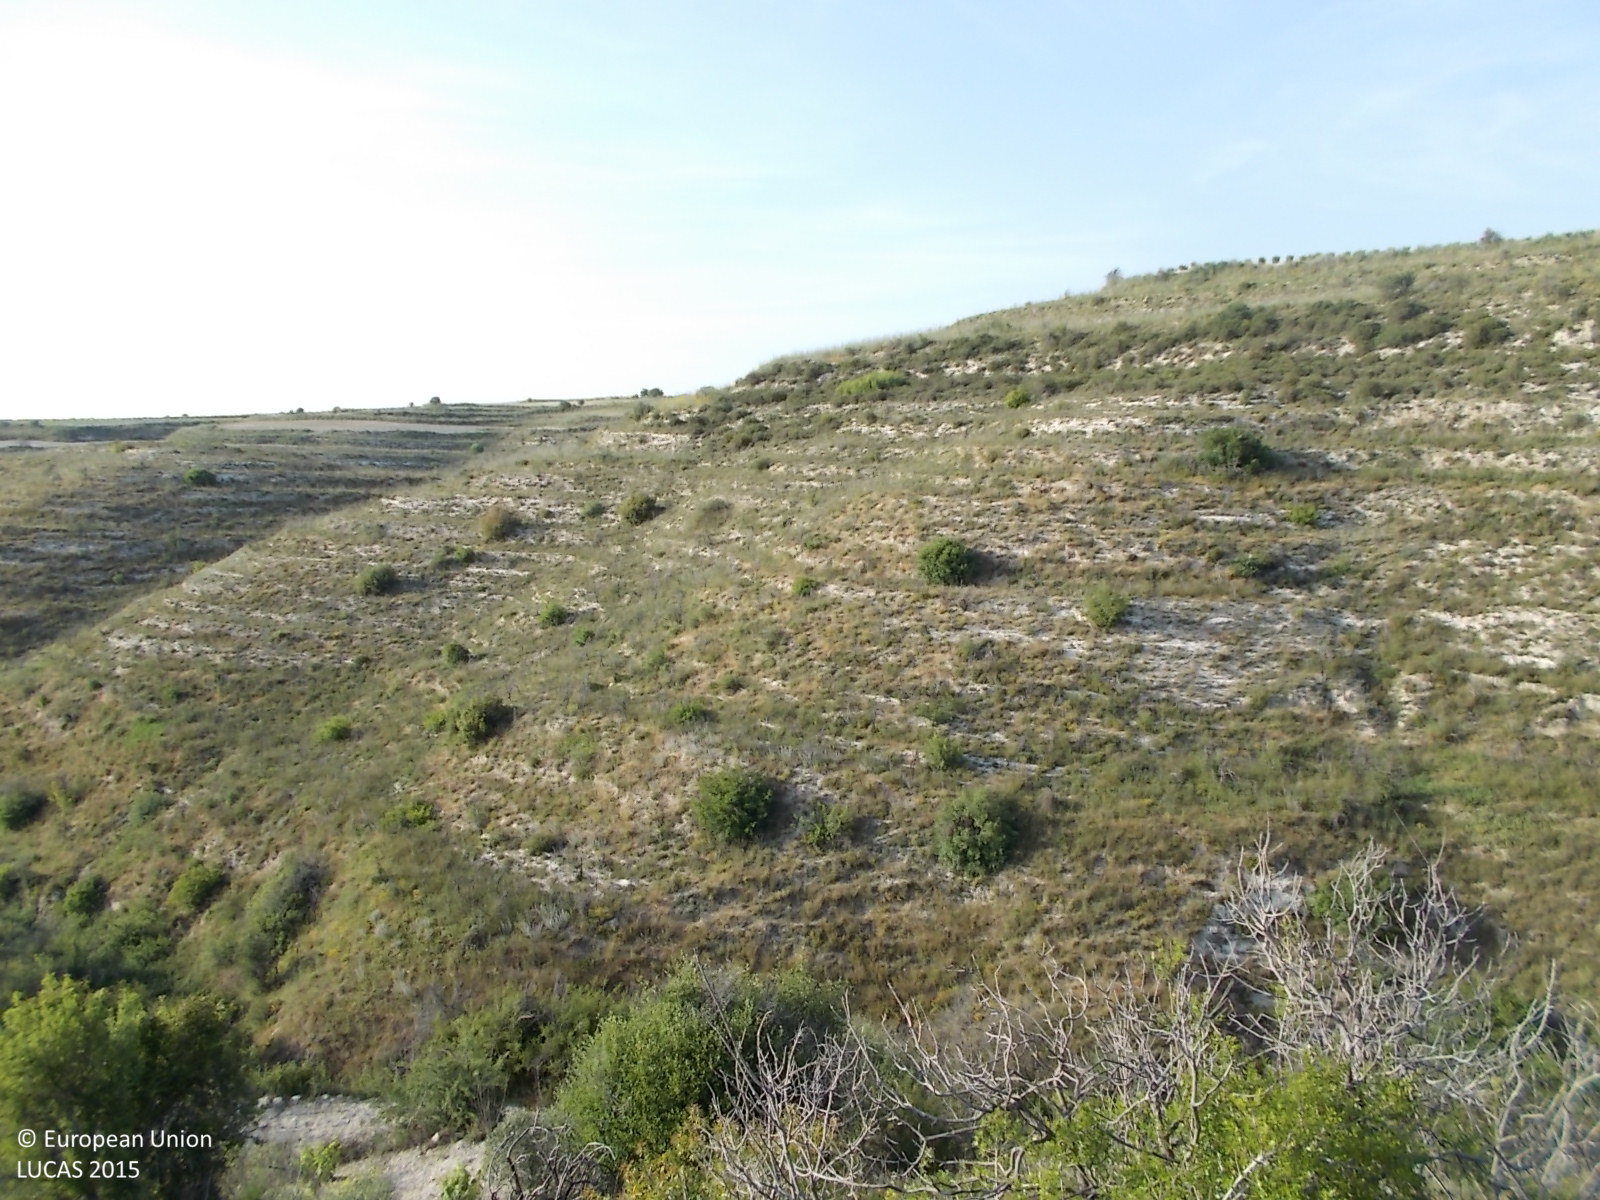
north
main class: Cropland
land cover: Vineyards
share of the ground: 25 - 50 %
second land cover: Other bare soil
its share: > 75 %
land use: Agriculture (excluding fallow land and kitchen gardens)
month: May
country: CY
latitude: 34.9082
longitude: 32.3984
